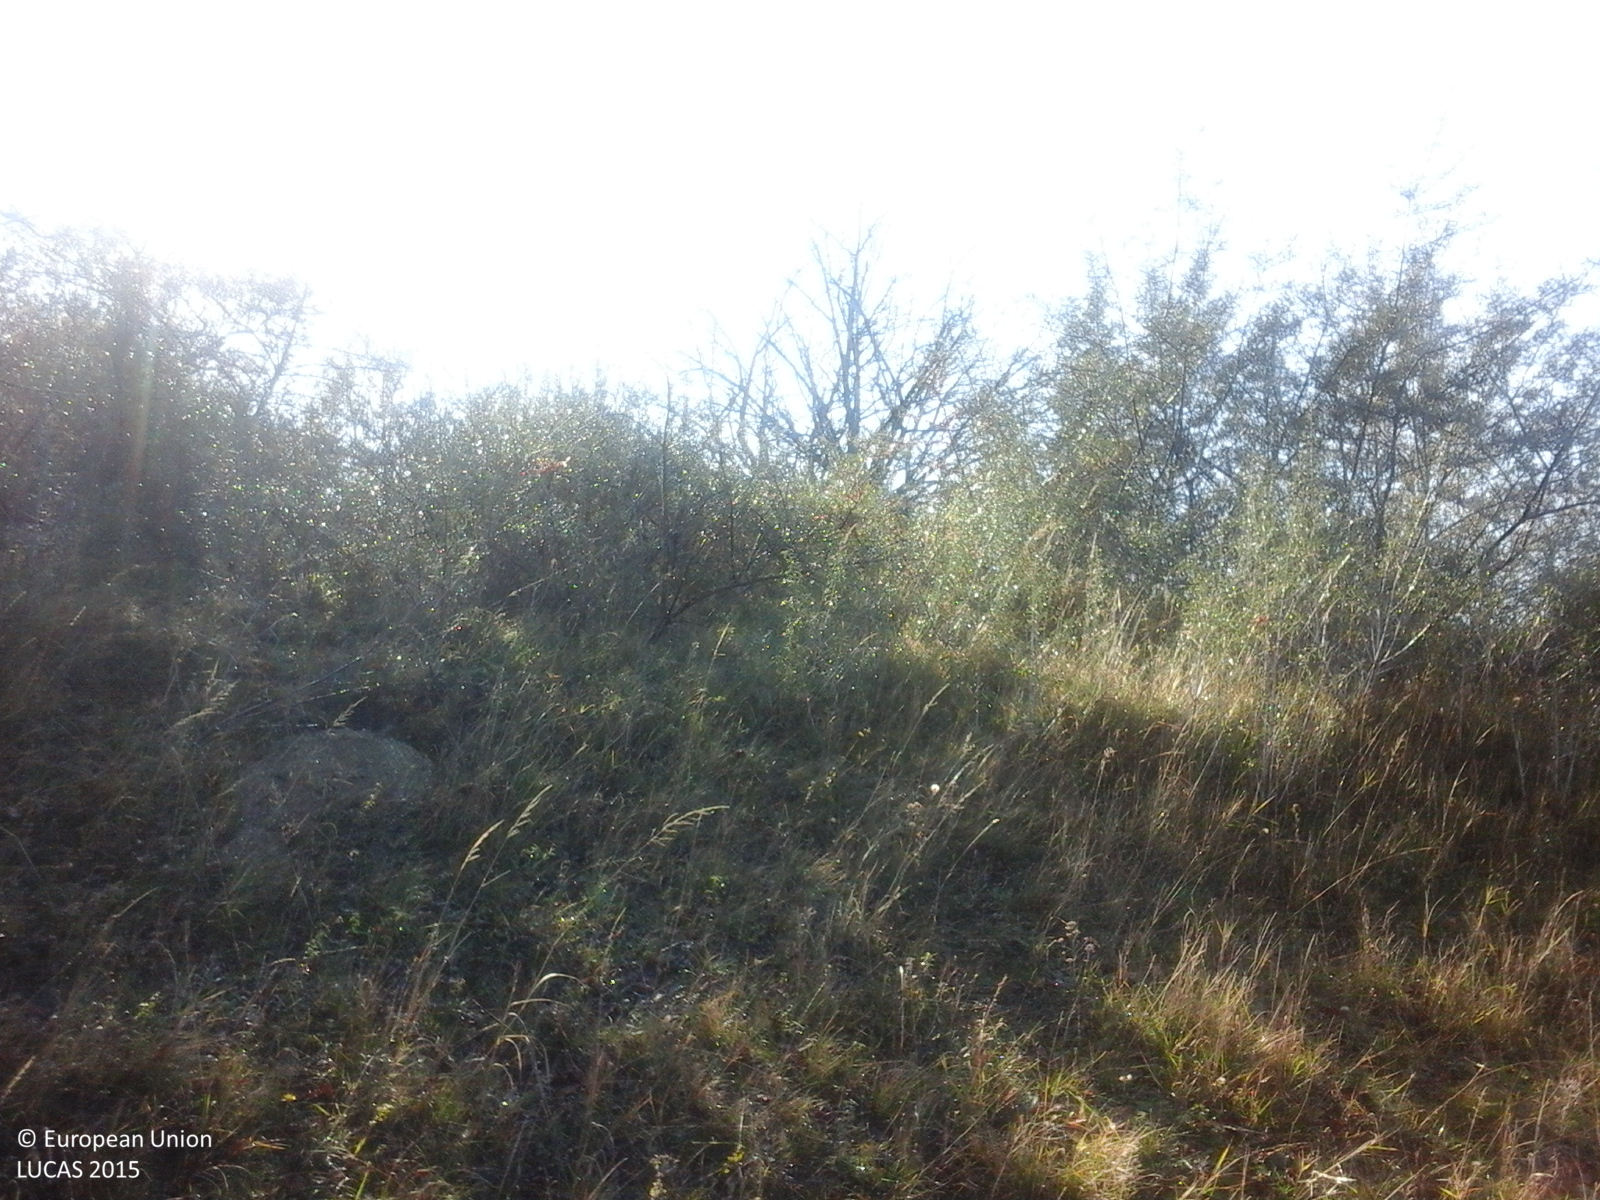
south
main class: Cropland
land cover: Other fruit trees and berries
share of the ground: > 75 %
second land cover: Grassland without tree/shrub cover
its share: > 75 %
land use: Agriculture (excluding fallow land and kitchen gardens)
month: October
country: RO
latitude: 45.4402
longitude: 26.8693
